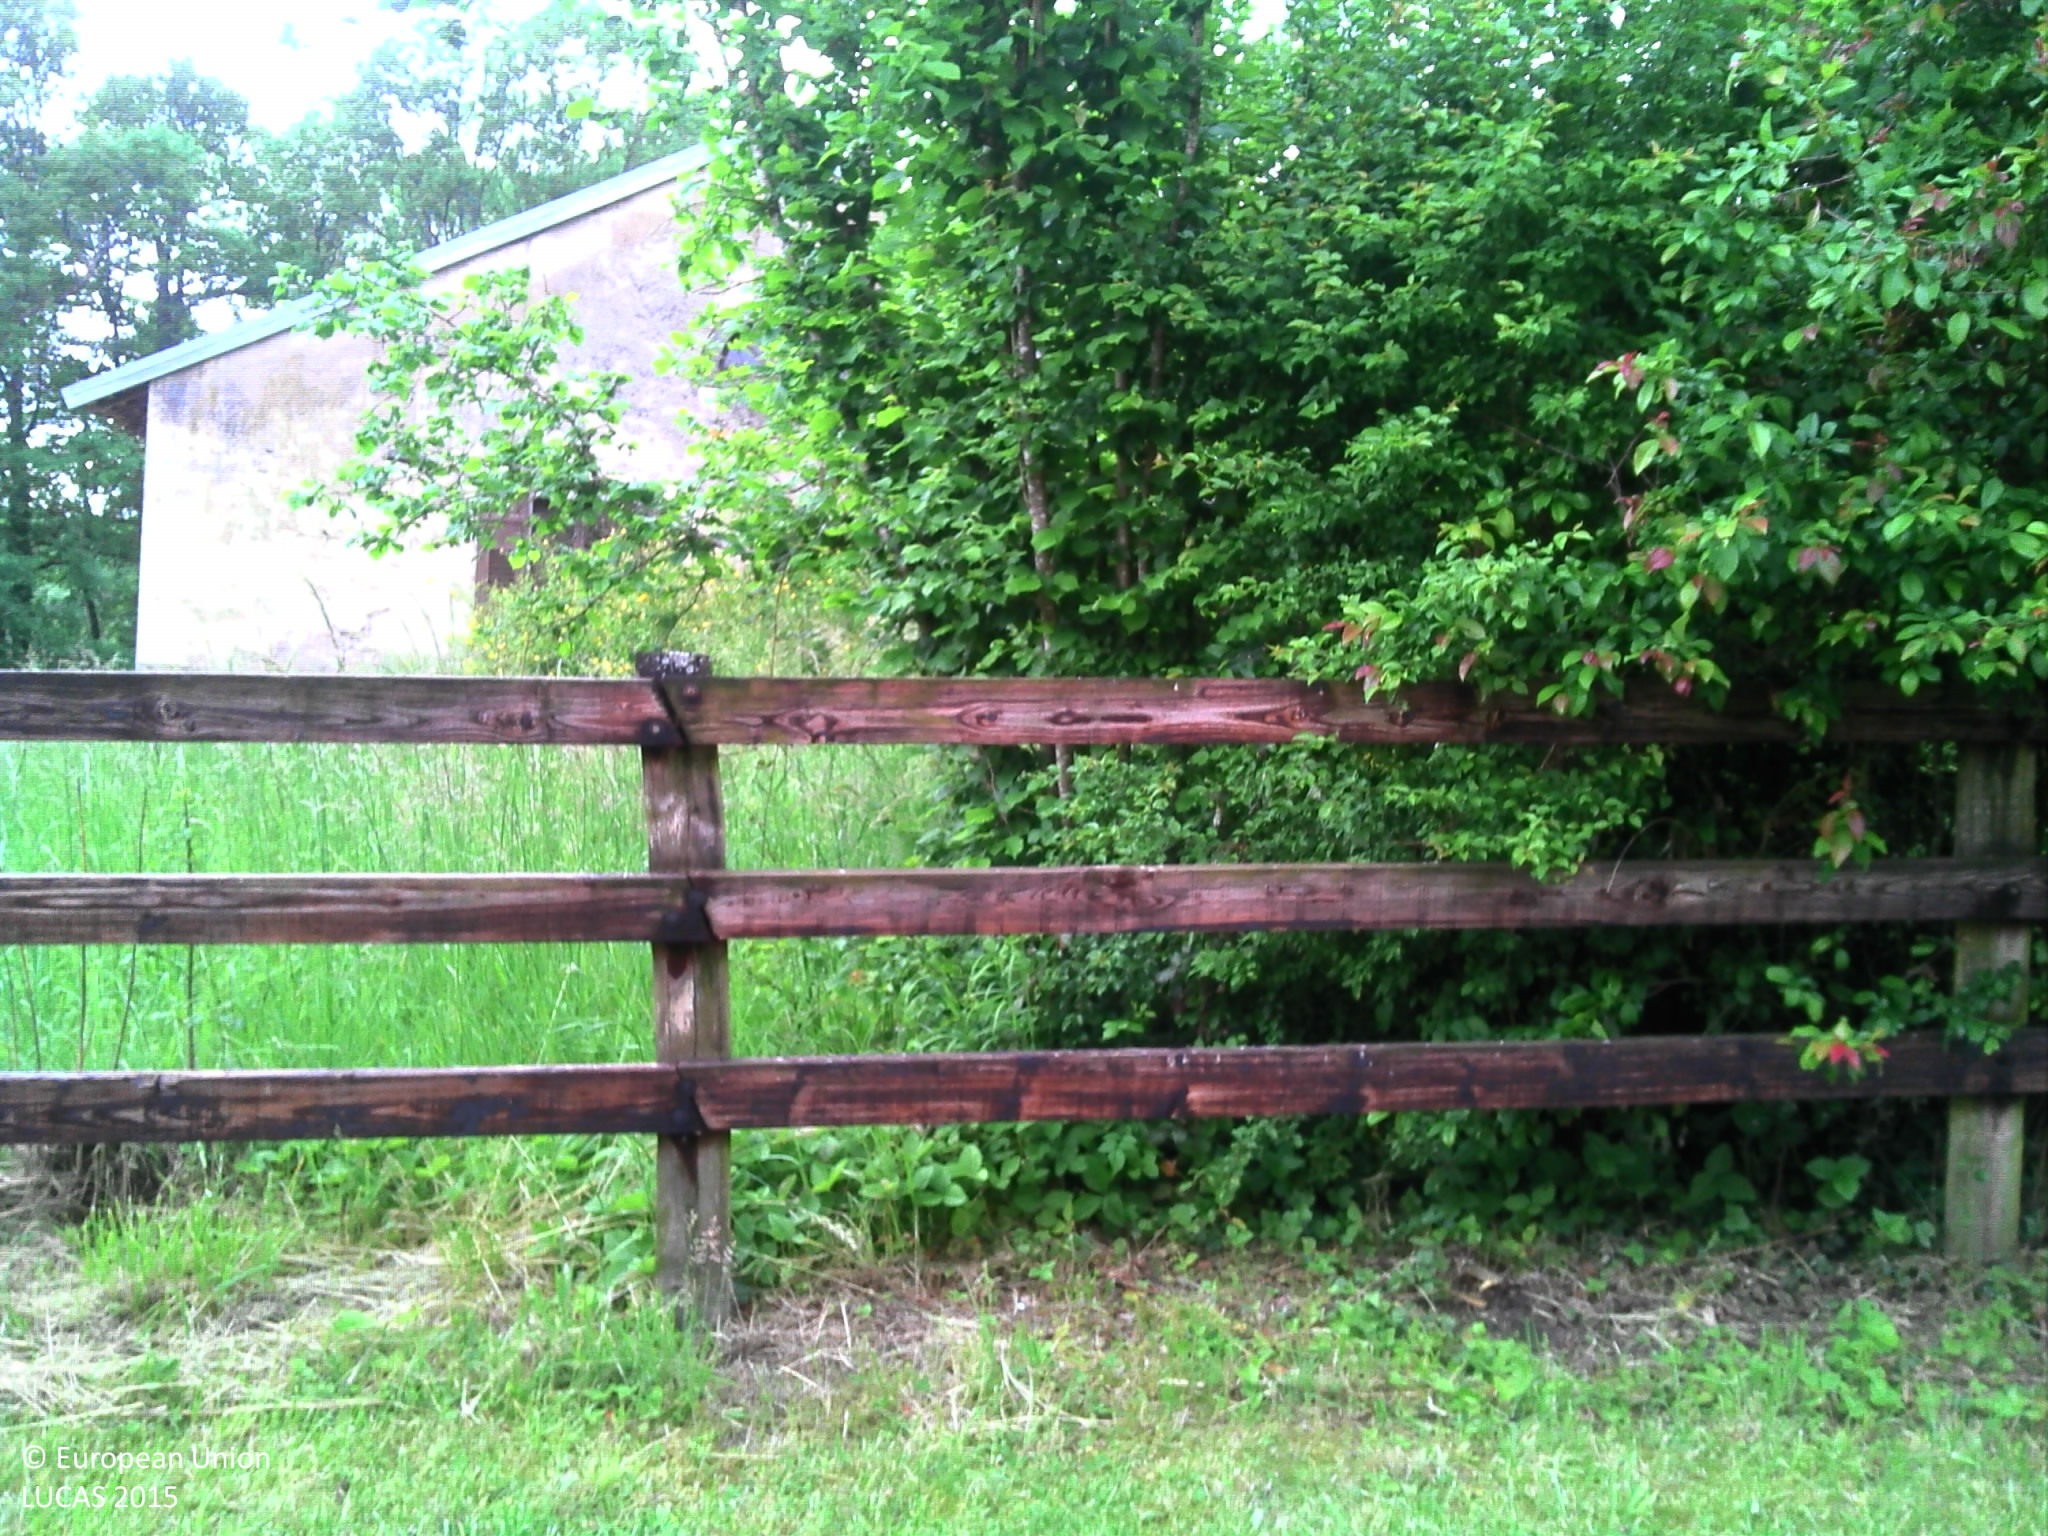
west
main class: Grassland
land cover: Grassland without tree/shrub cover
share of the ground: > 75 %
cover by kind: herbaceous plants 90 %, unconsolidated bare surface 10 %
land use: Road transport
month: May
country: FR
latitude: 47.9575
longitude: 6.1306
